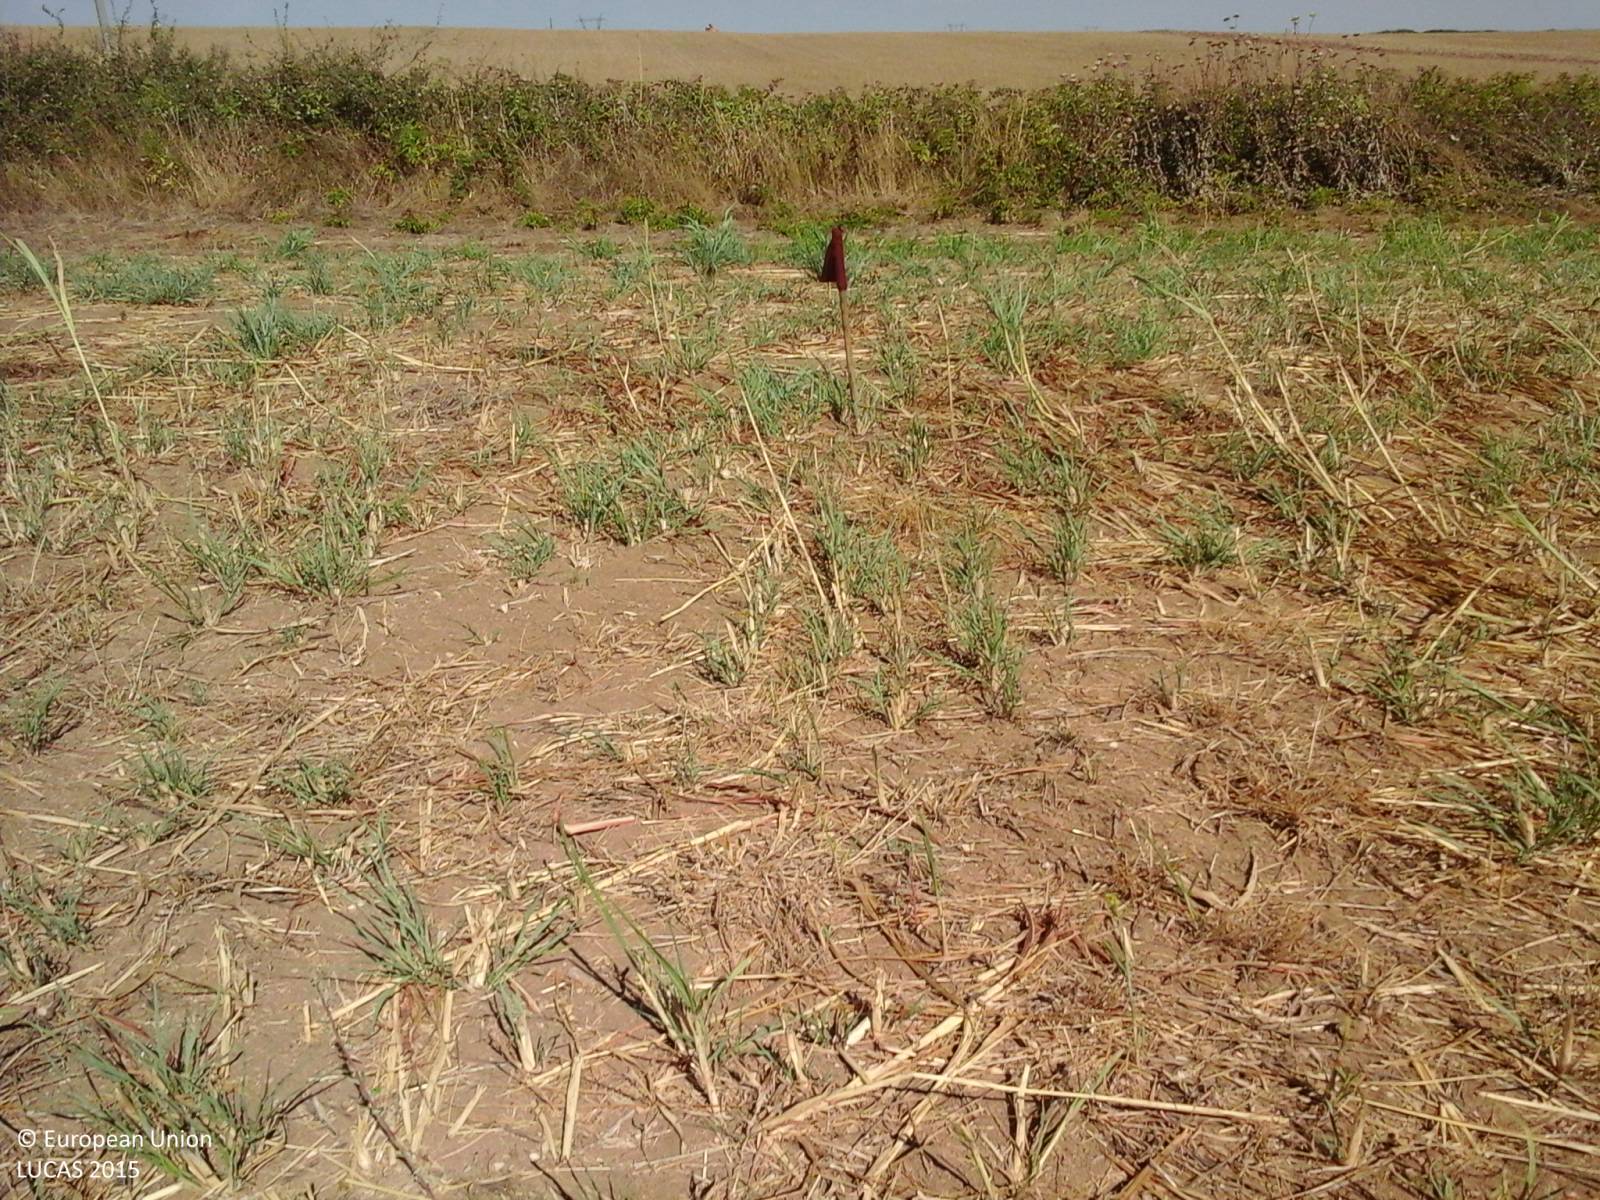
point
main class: Cropland
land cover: Maize
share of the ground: > 75 %
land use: Agriculture (excluding fallow land and kitchen gardens)
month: August
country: IT
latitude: 42.0513
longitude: 12.2271
